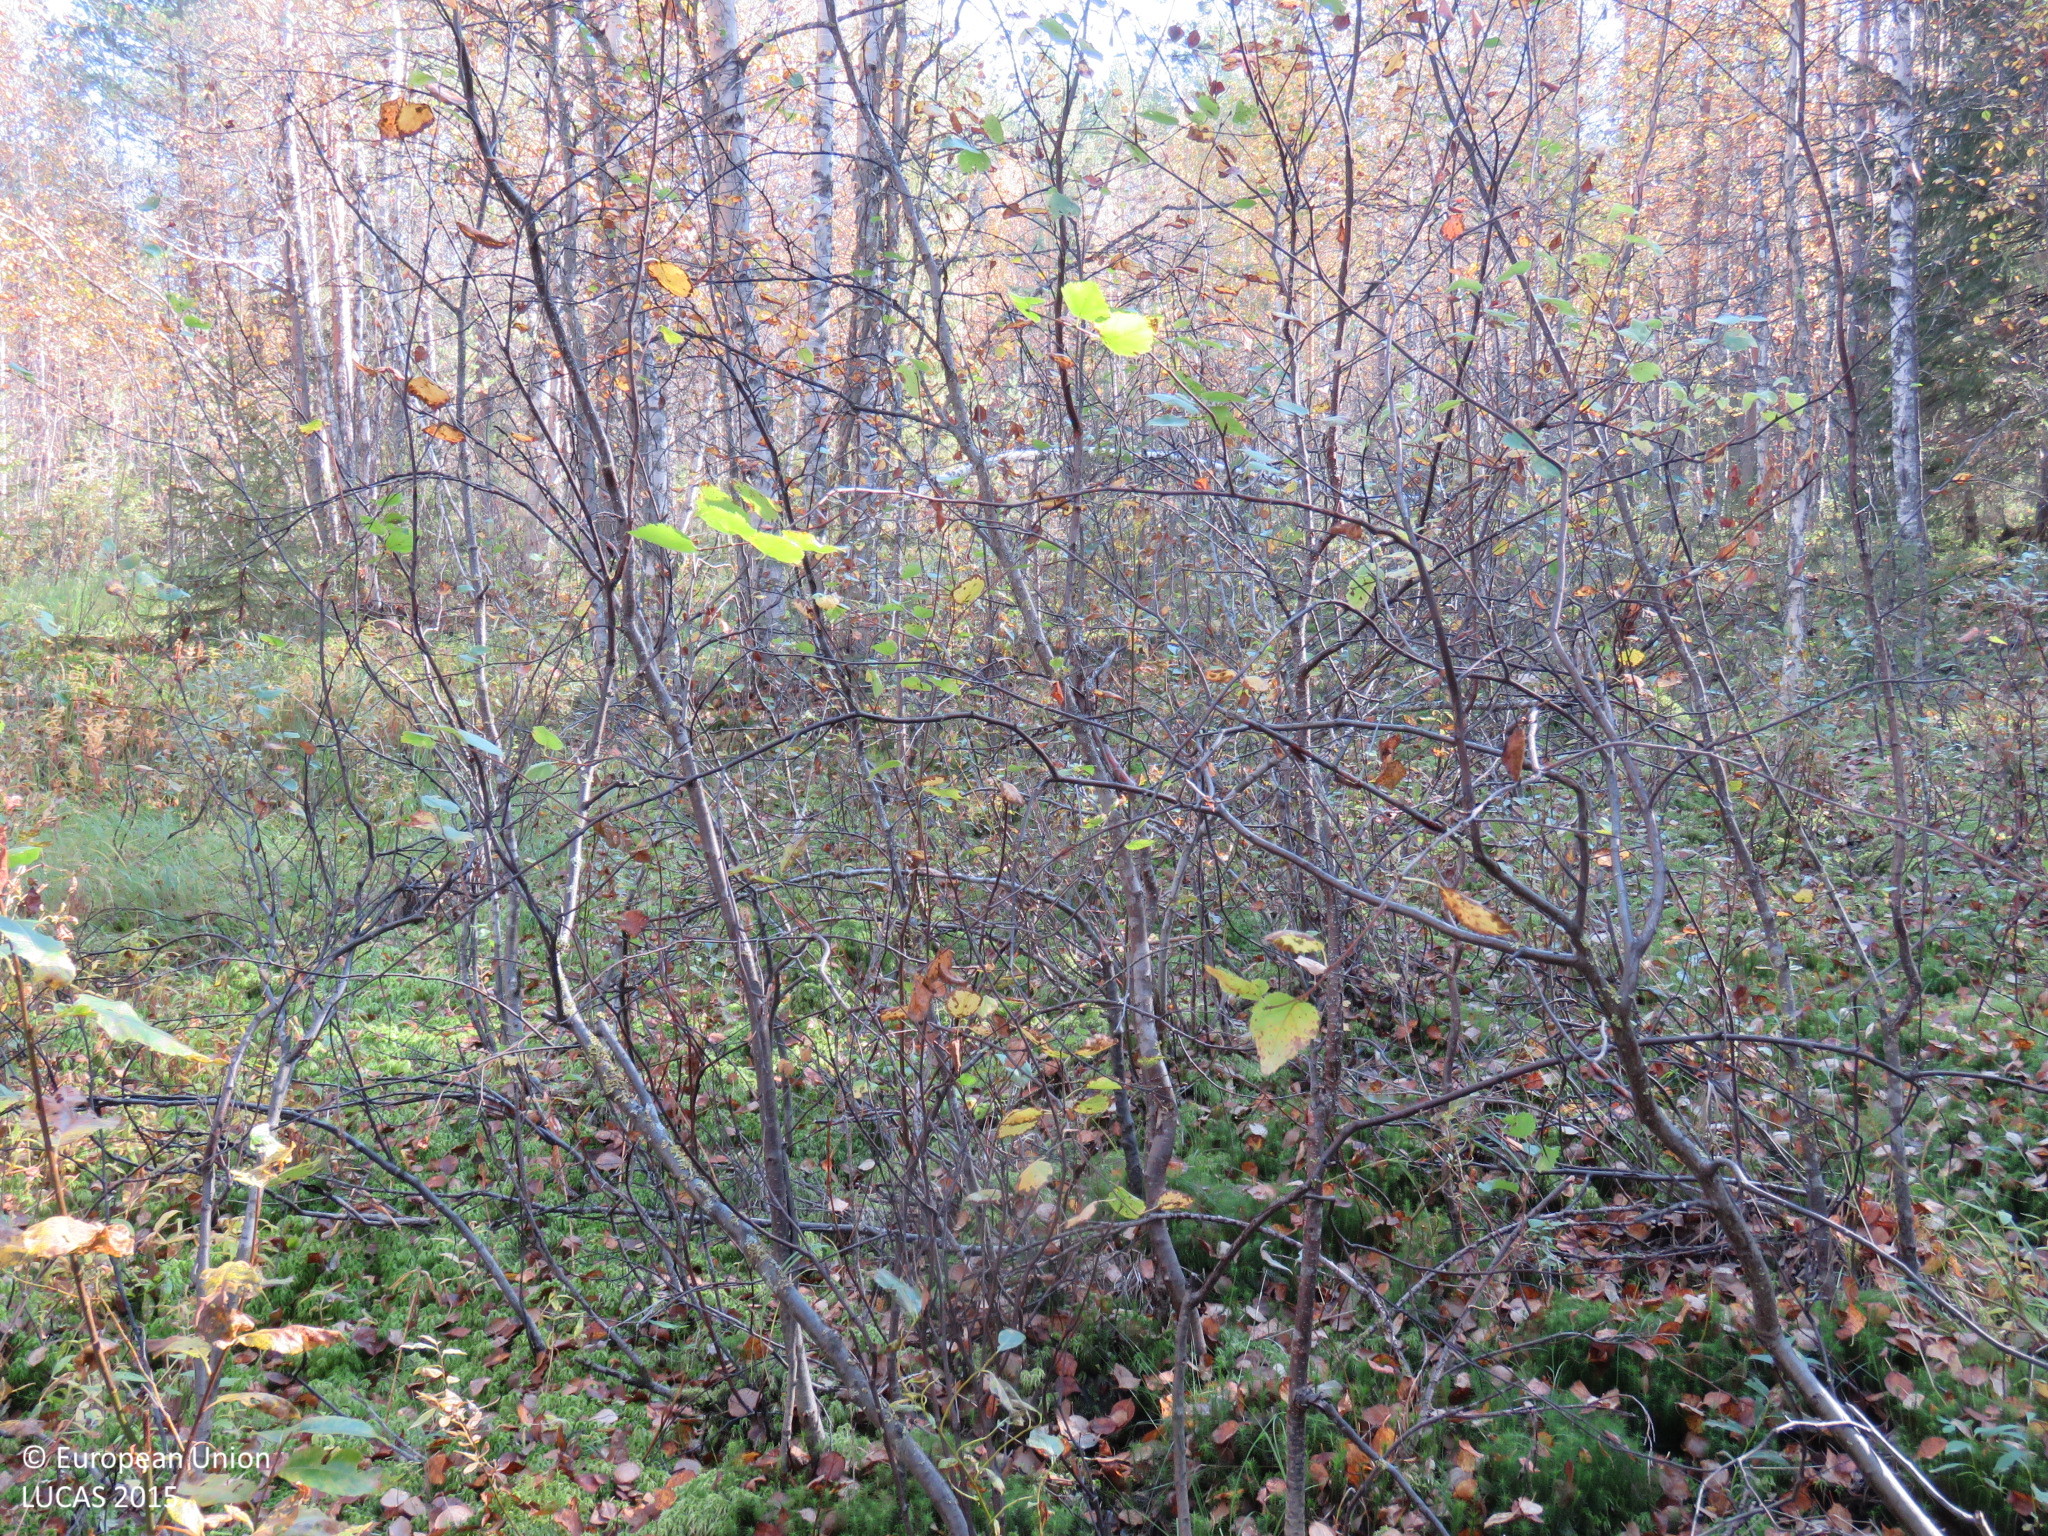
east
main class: Woodland
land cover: Broadleaved woodland
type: mire and swamp forests
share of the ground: > 75 %
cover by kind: broadleaved forest trees 75 %, coniferous forest trees 10 %, herbaceous plants 10 %, lichens and mosses 5 %
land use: Forestry
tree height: > 5 m
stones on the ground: < 10 %
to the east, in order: Broadleaved woodland; Pine dominated mixed woodland; Inland marshes; Other mixed woodland; Inland marshes; Broadleaved woodland; Electric lines; Broadleaved woodland; Other coniferous woodland; Ditches and canals; Pine dominated mixed woodland; Ditches and canals; Pine dominated mixed woodland; Ditches and canals; Other mixed woodland; Other coniferous woodland
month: September
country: FI
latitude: 64.9441
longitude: 26.9450
